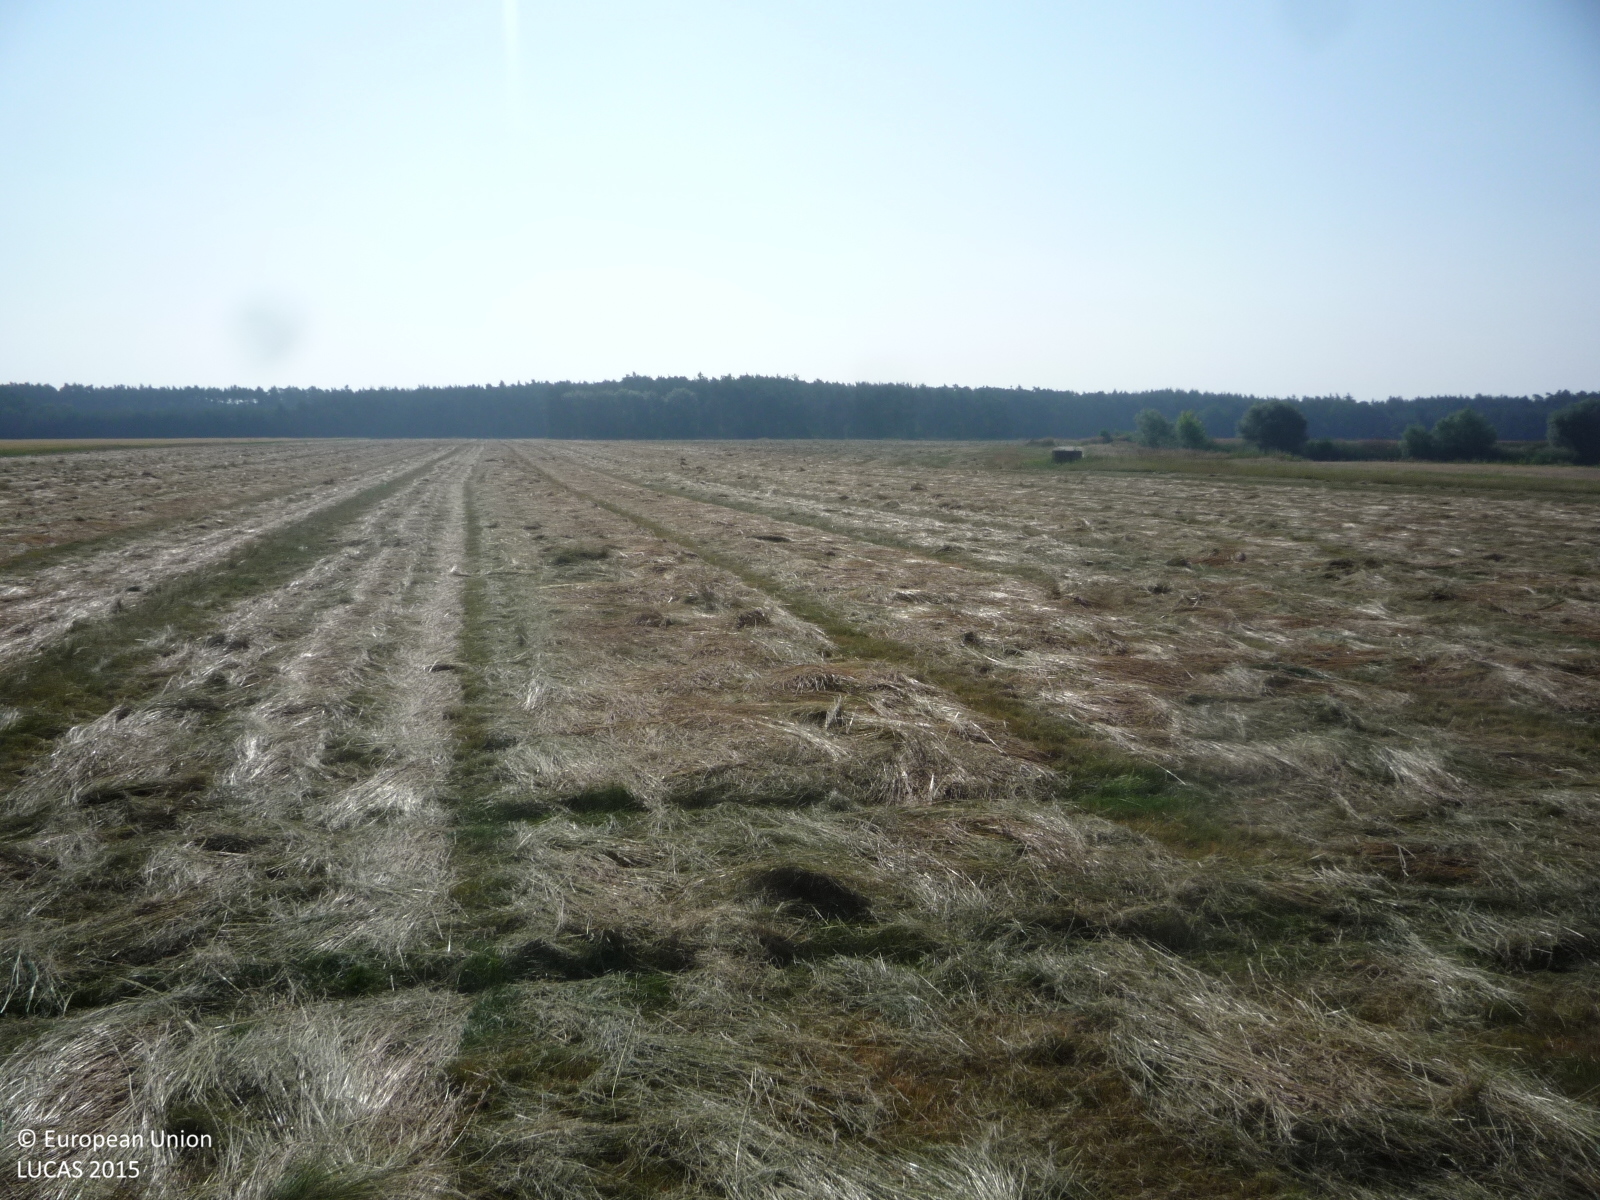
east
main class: Grassland
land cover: Grassland without tree/shrub cover
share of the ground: > 75 %
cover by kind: herbaceous plants 100 %
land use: Agriculture (excluding fallow land and kitchen gardens)
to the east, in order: Grassland without tree/shrub cover
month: July
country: CZ
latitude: 50.0842
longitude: 15.1881
